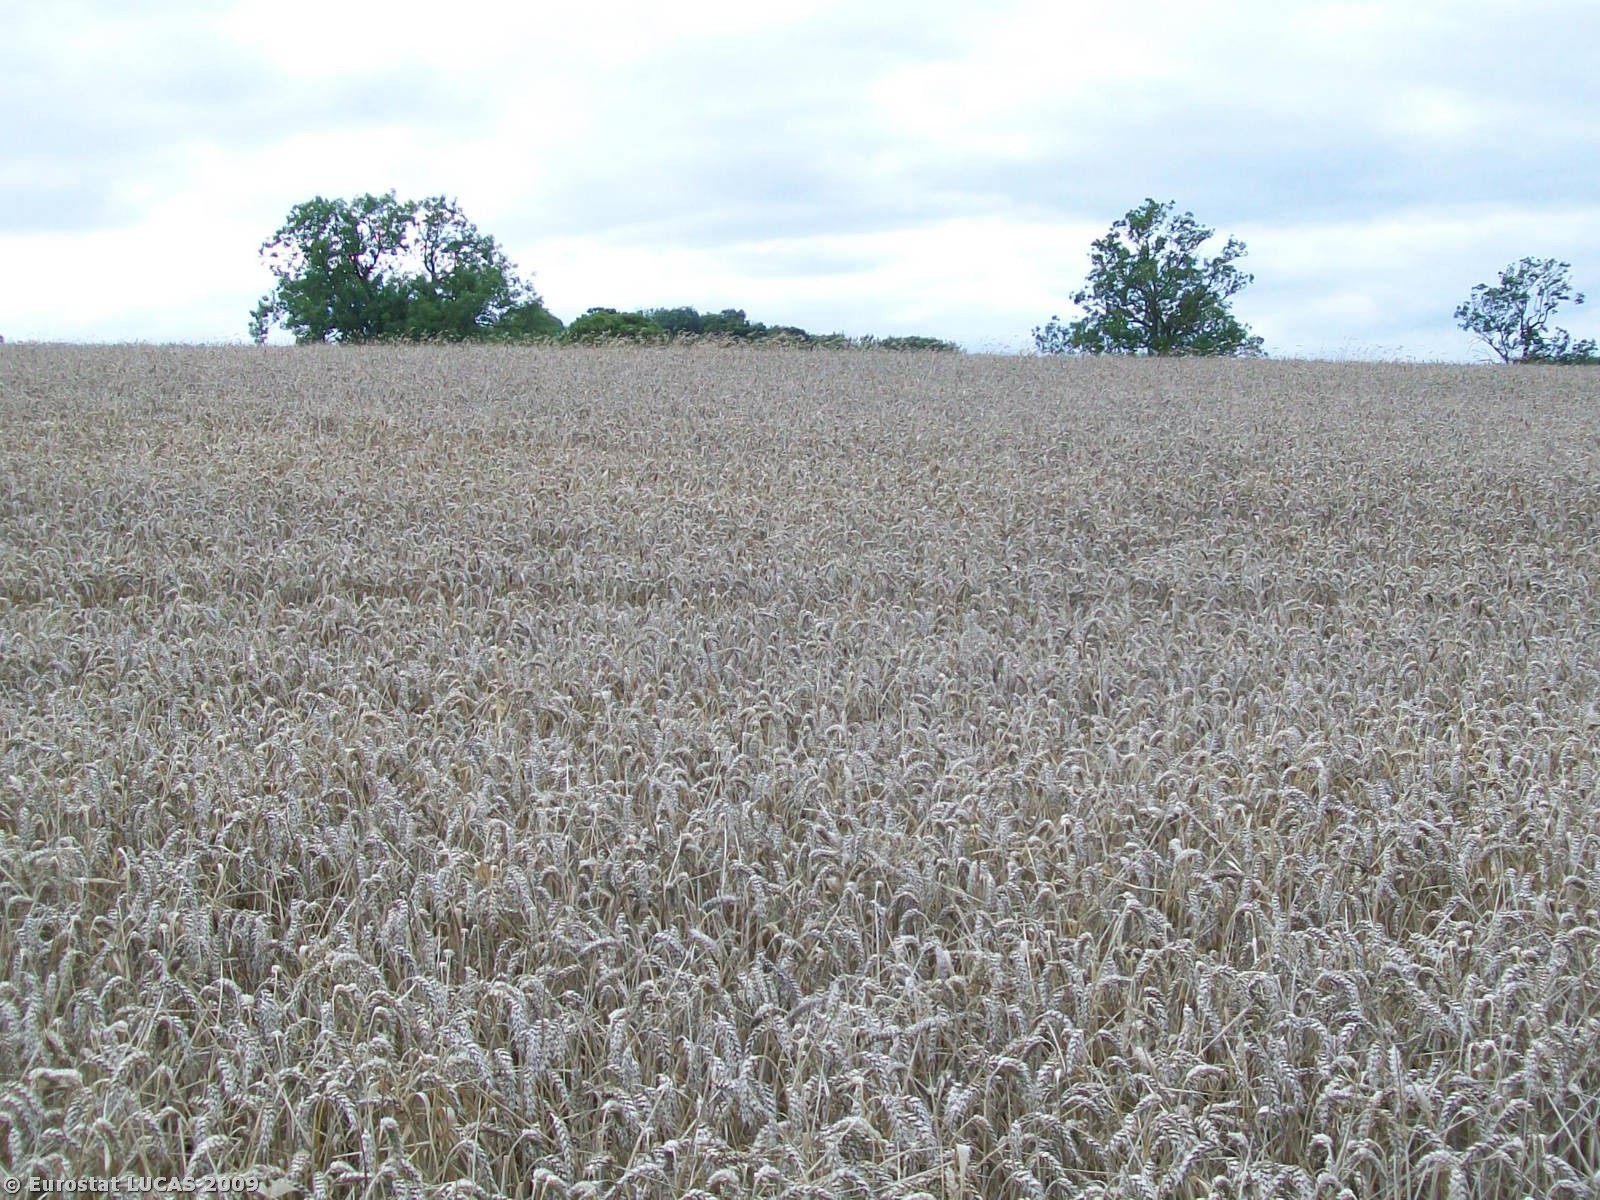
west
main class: Cropland
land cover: Common wheat
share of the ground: > 75 %
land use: Agriculture (excluding fallow land and kitchen gardens)
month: August
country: GB
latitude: 52.3331
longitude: -1.0365
